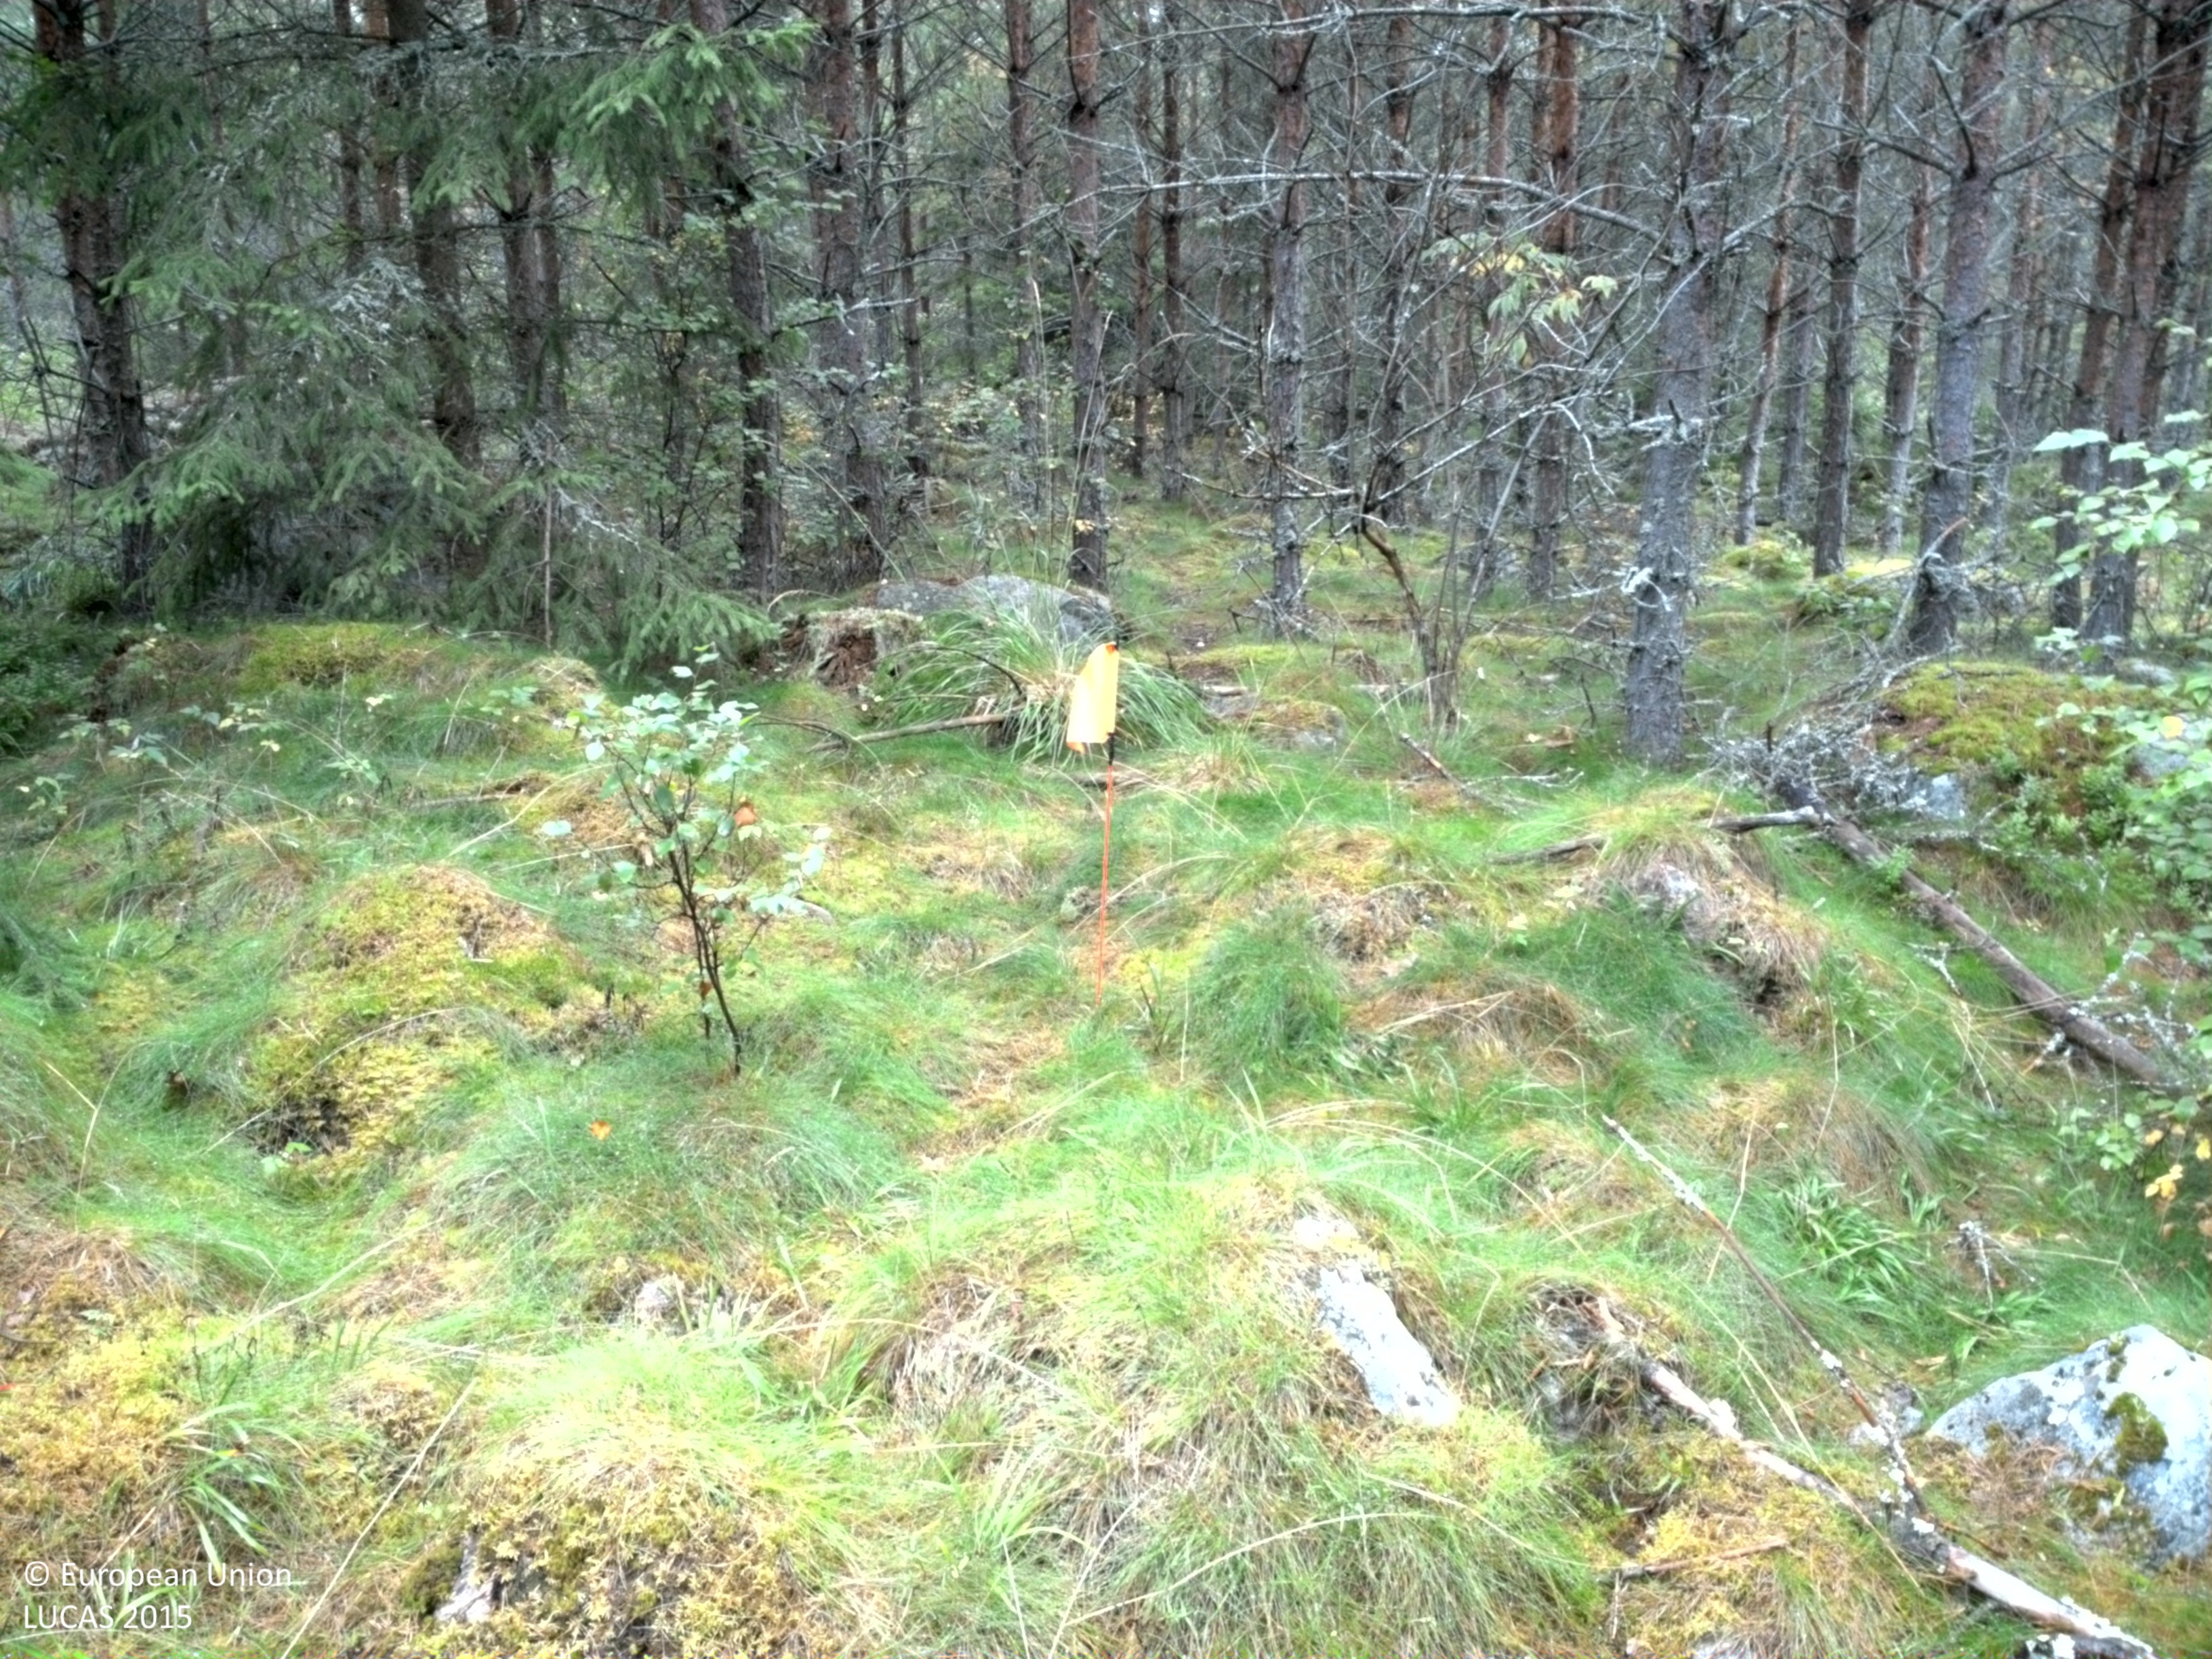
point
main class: Woodland
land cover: Pine dominated coniferous woodland
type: boreal forest
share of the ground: 50 - 75 %
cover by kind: coniferous forest trees 65 %, herbaceous plants 25 %, broadleaved forest trees 10 %
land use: Forestry
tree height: > 5 m
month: August
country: SE
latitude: 59.9355
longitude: 17.6713
